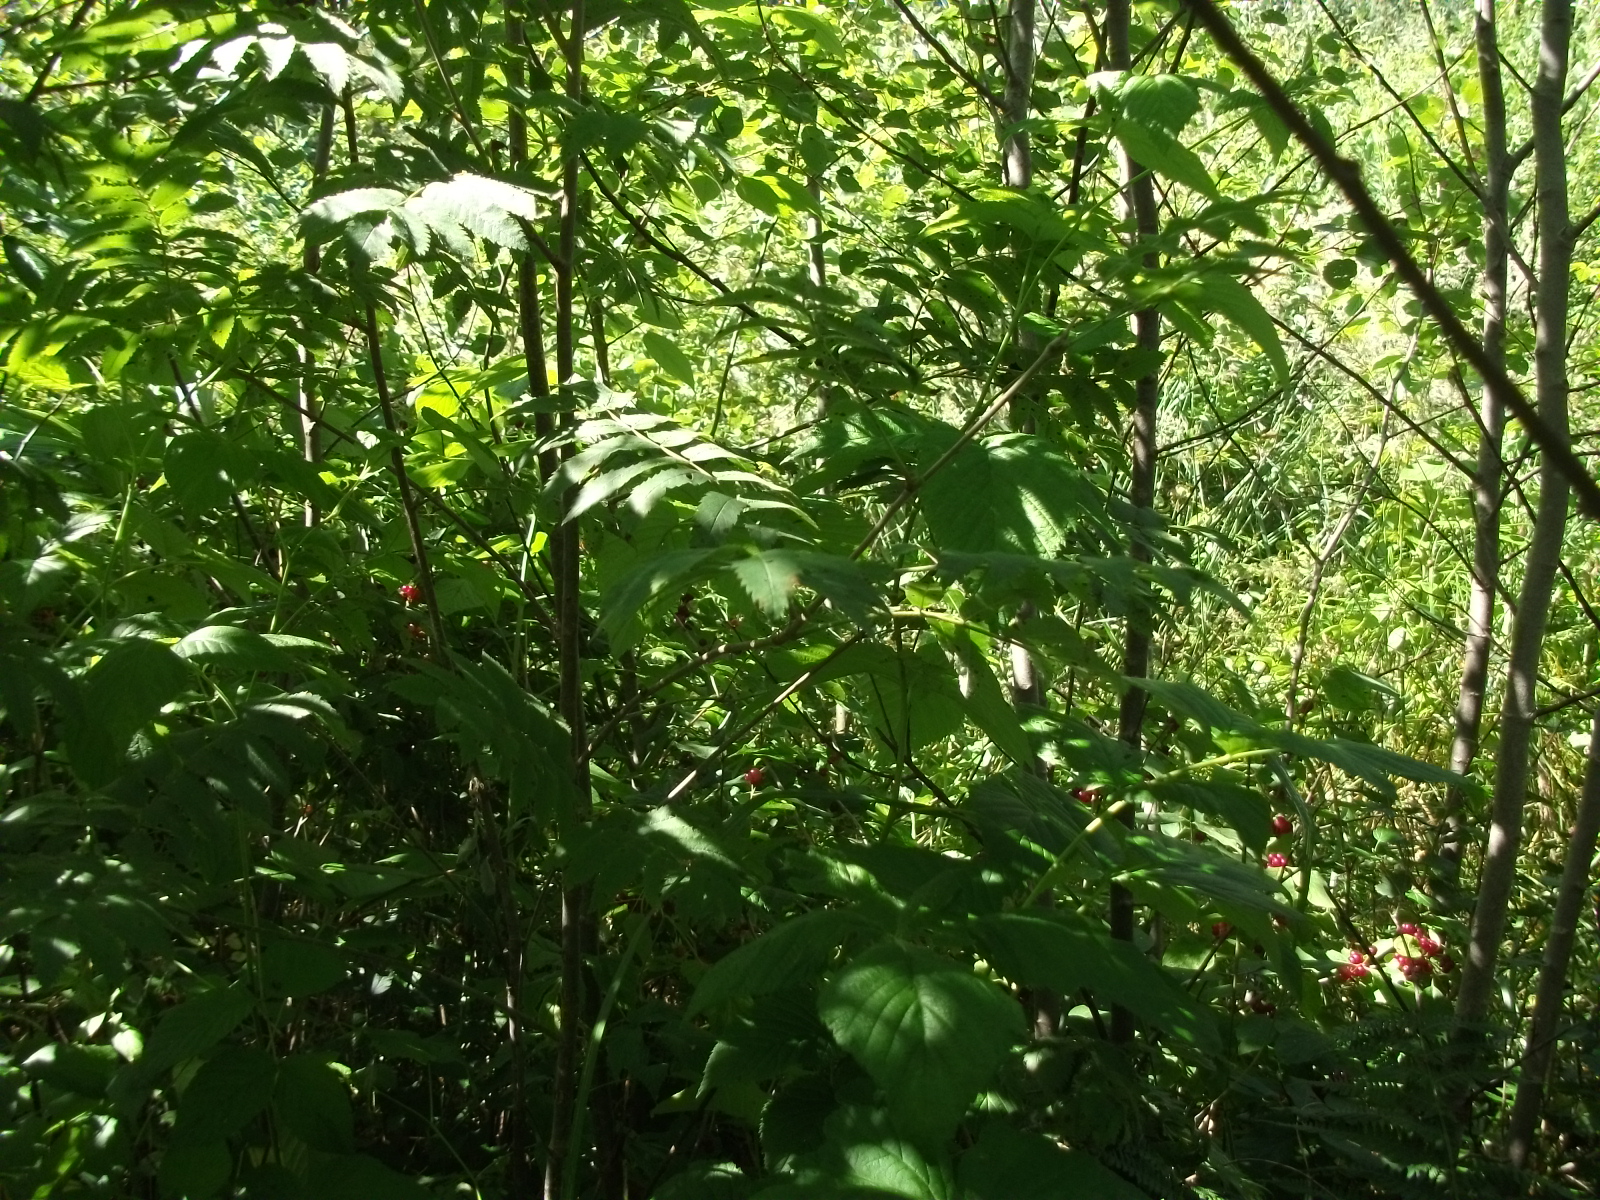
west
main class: Woodland
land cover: Broadleaved woodland
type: non-riverine alder, birch or aspen forest
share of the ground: > 75 %
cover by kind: broadleaved forest trees 95 %, shrubs 5 %
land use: Forestry
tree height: < 5 m
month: August
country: LV
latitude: 56.9917
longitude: 26.4550
